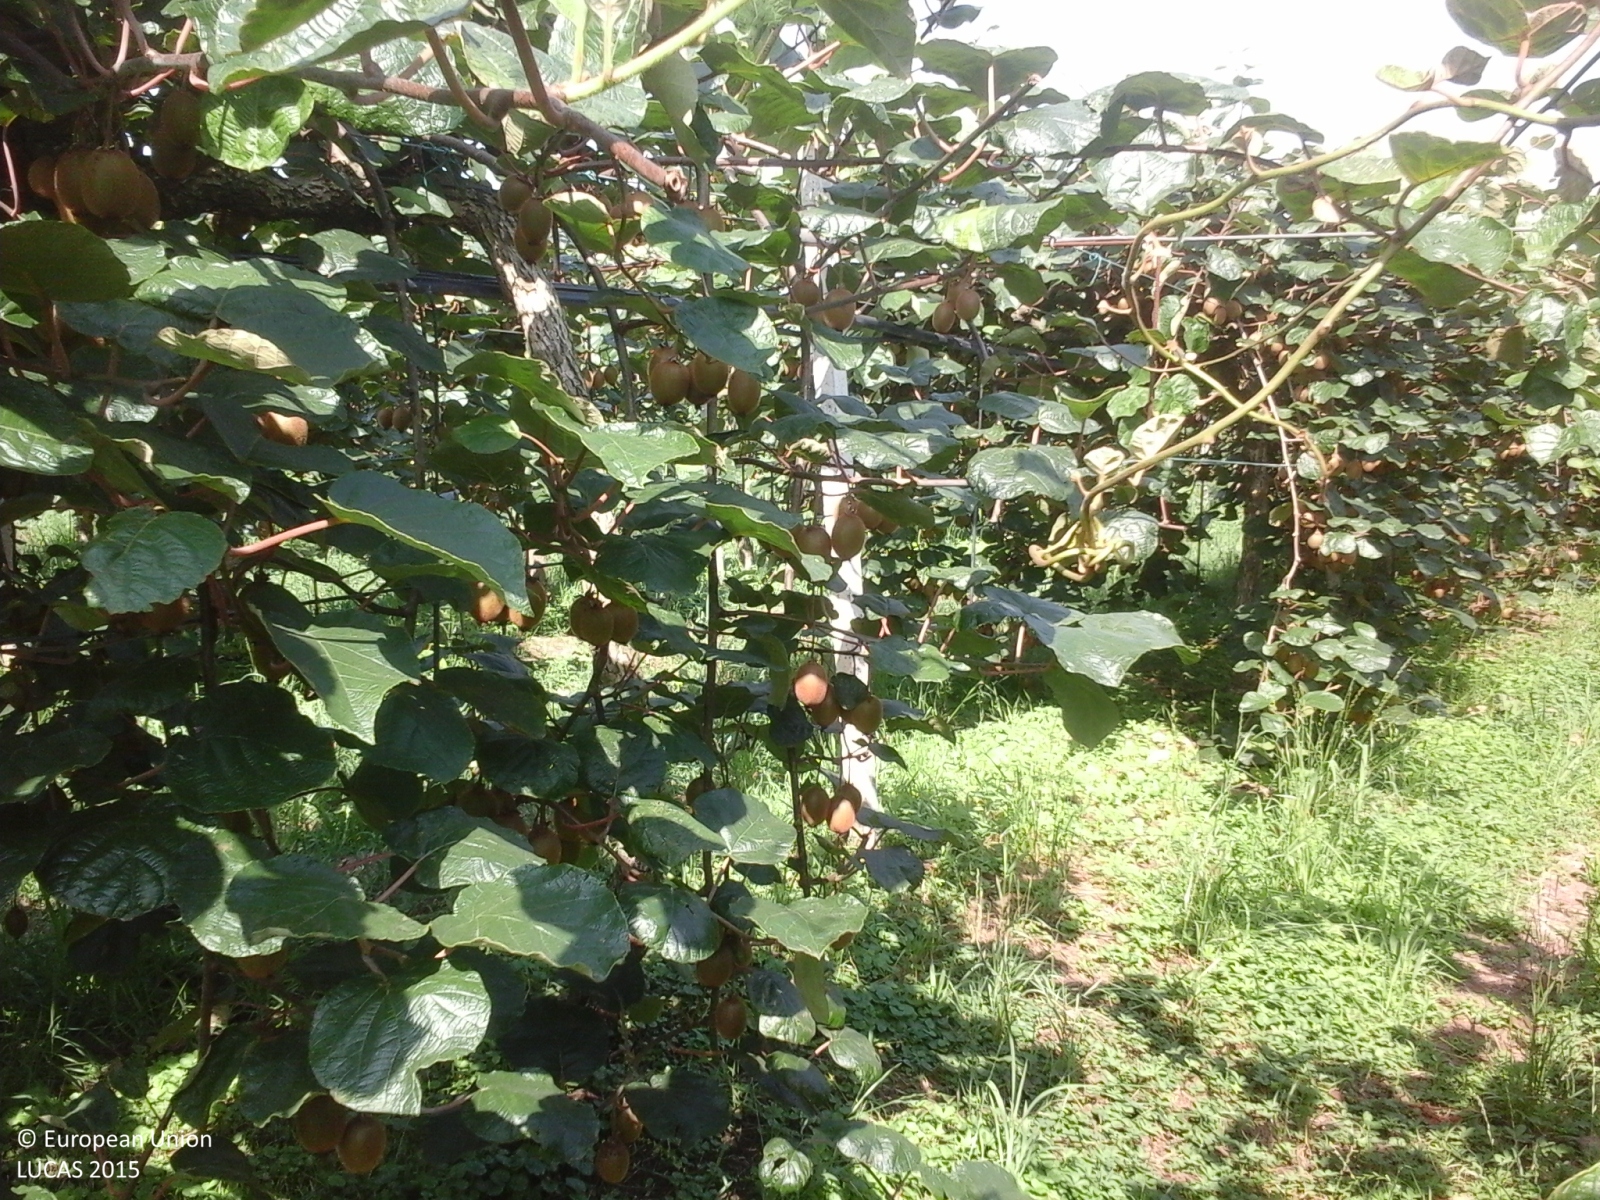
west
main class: Cropland
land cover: Other fruit trees and berries
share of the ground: > 75 %
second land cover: Grassland without tree/shrub cover
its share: > 75 %
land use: Agriculture (excluding fallow land and kitchen gardens)
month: July
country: IT
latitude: 45.3211
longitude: 10.8023
